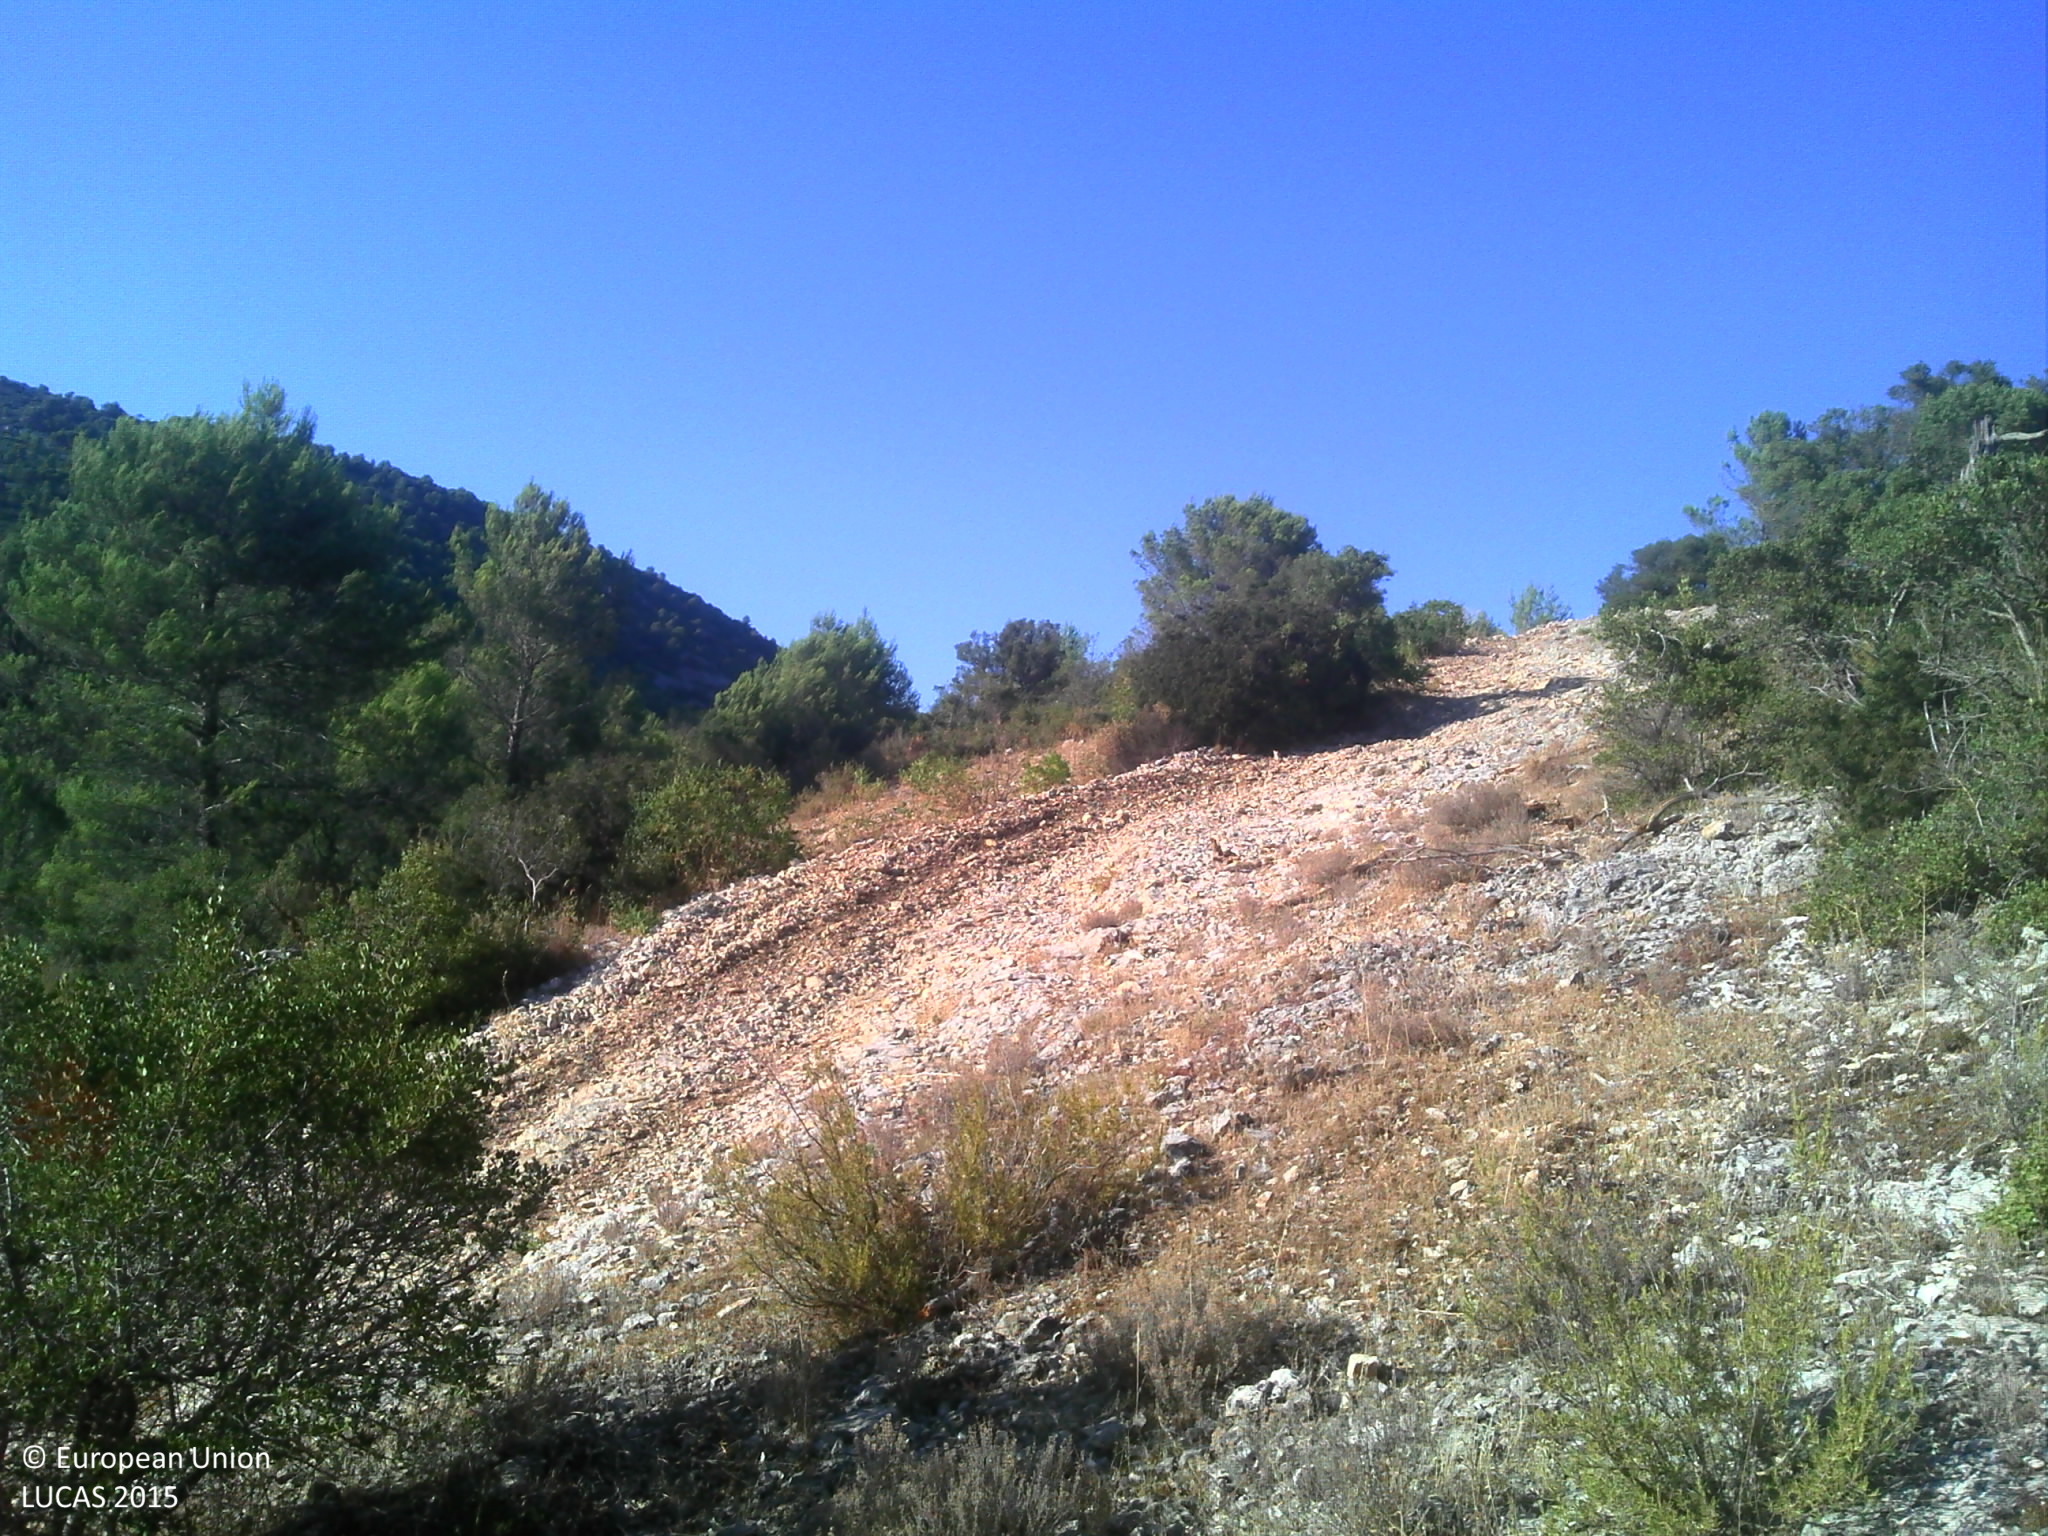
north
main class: Woodland
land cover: Pine dominated coniferous woodland
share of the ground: 50 - 75 %
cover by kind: coniferous forest trees 35 %, shrubs 30 %, herbaceous plants 15 %, unconsolidated bare surface 15 %, broadleaved forest trees 5 %
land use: Forestry
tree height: < 5 m
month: August
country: FR
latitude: 43.2703
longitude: 5.7594
